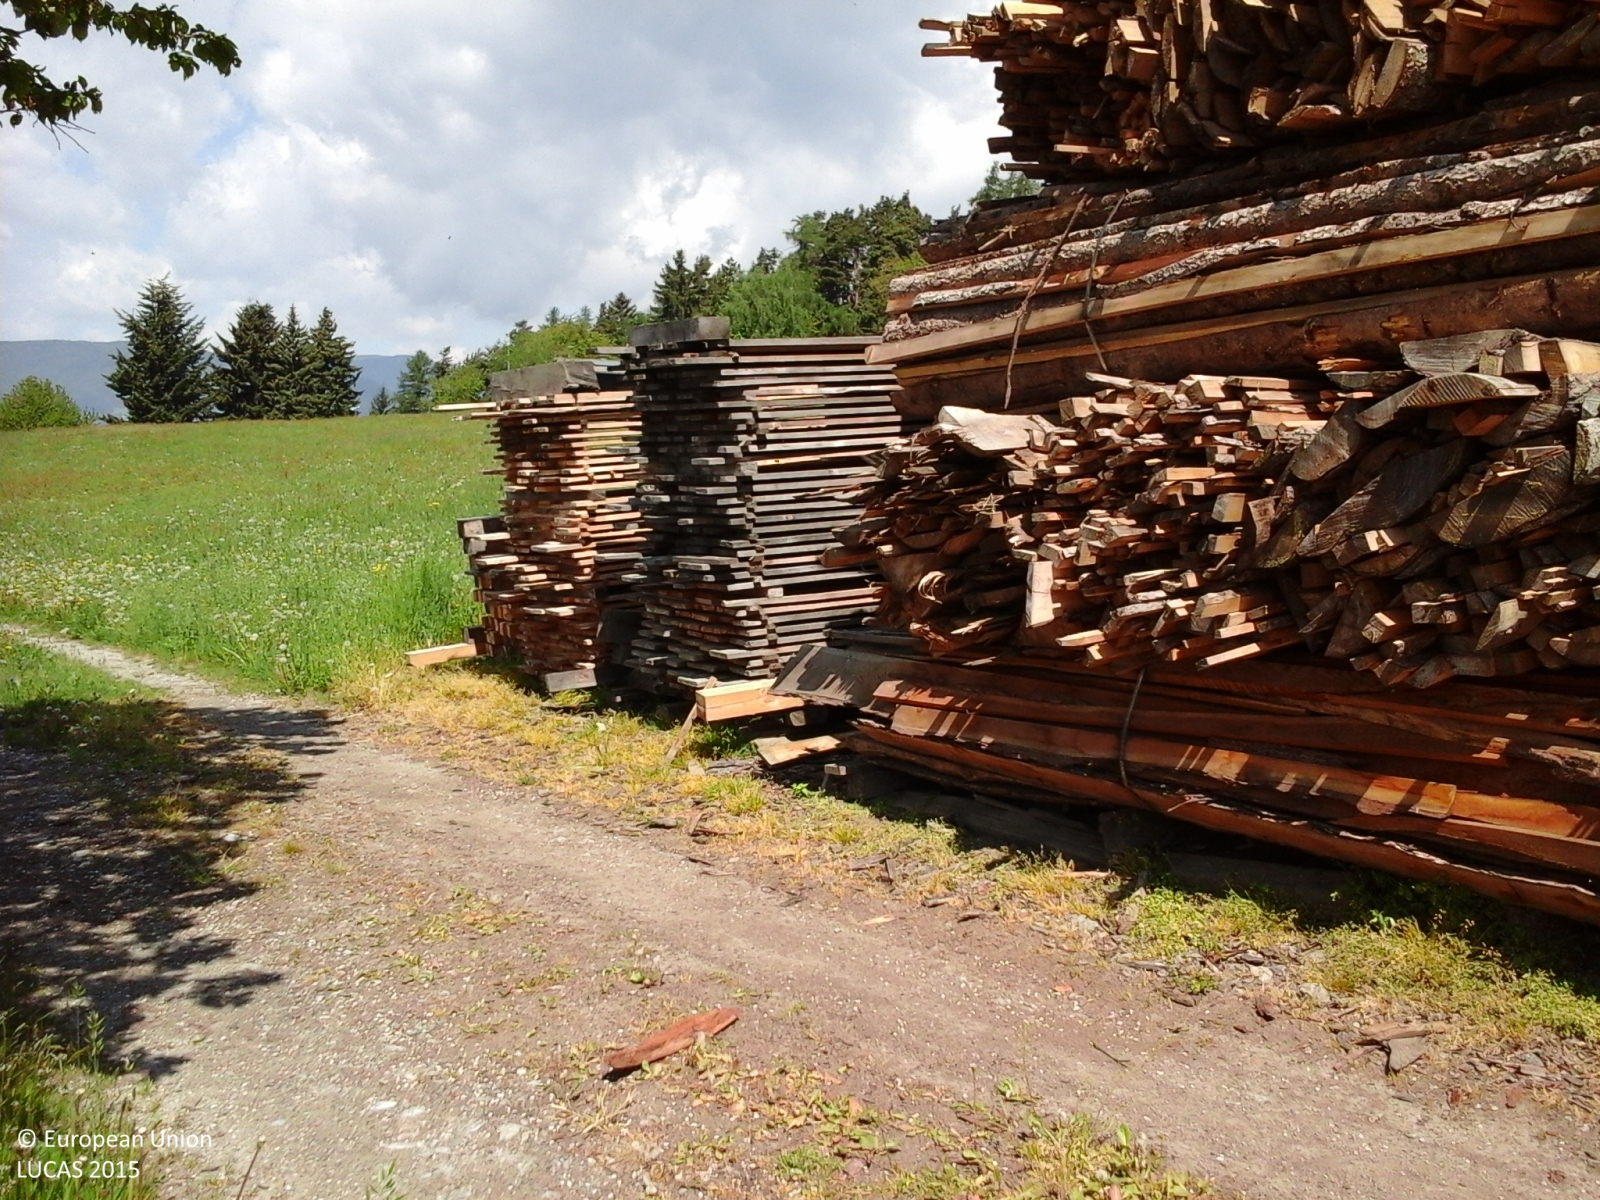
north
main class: Grassland
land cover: Grassland without tree/shrub cover
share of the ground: > 75 %
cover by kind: herbaceous plants 100 %
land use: Agriculture (excluding fallow land and kitchen gardens)
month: May
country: IT
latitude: 46.6098
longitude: 11.5780
